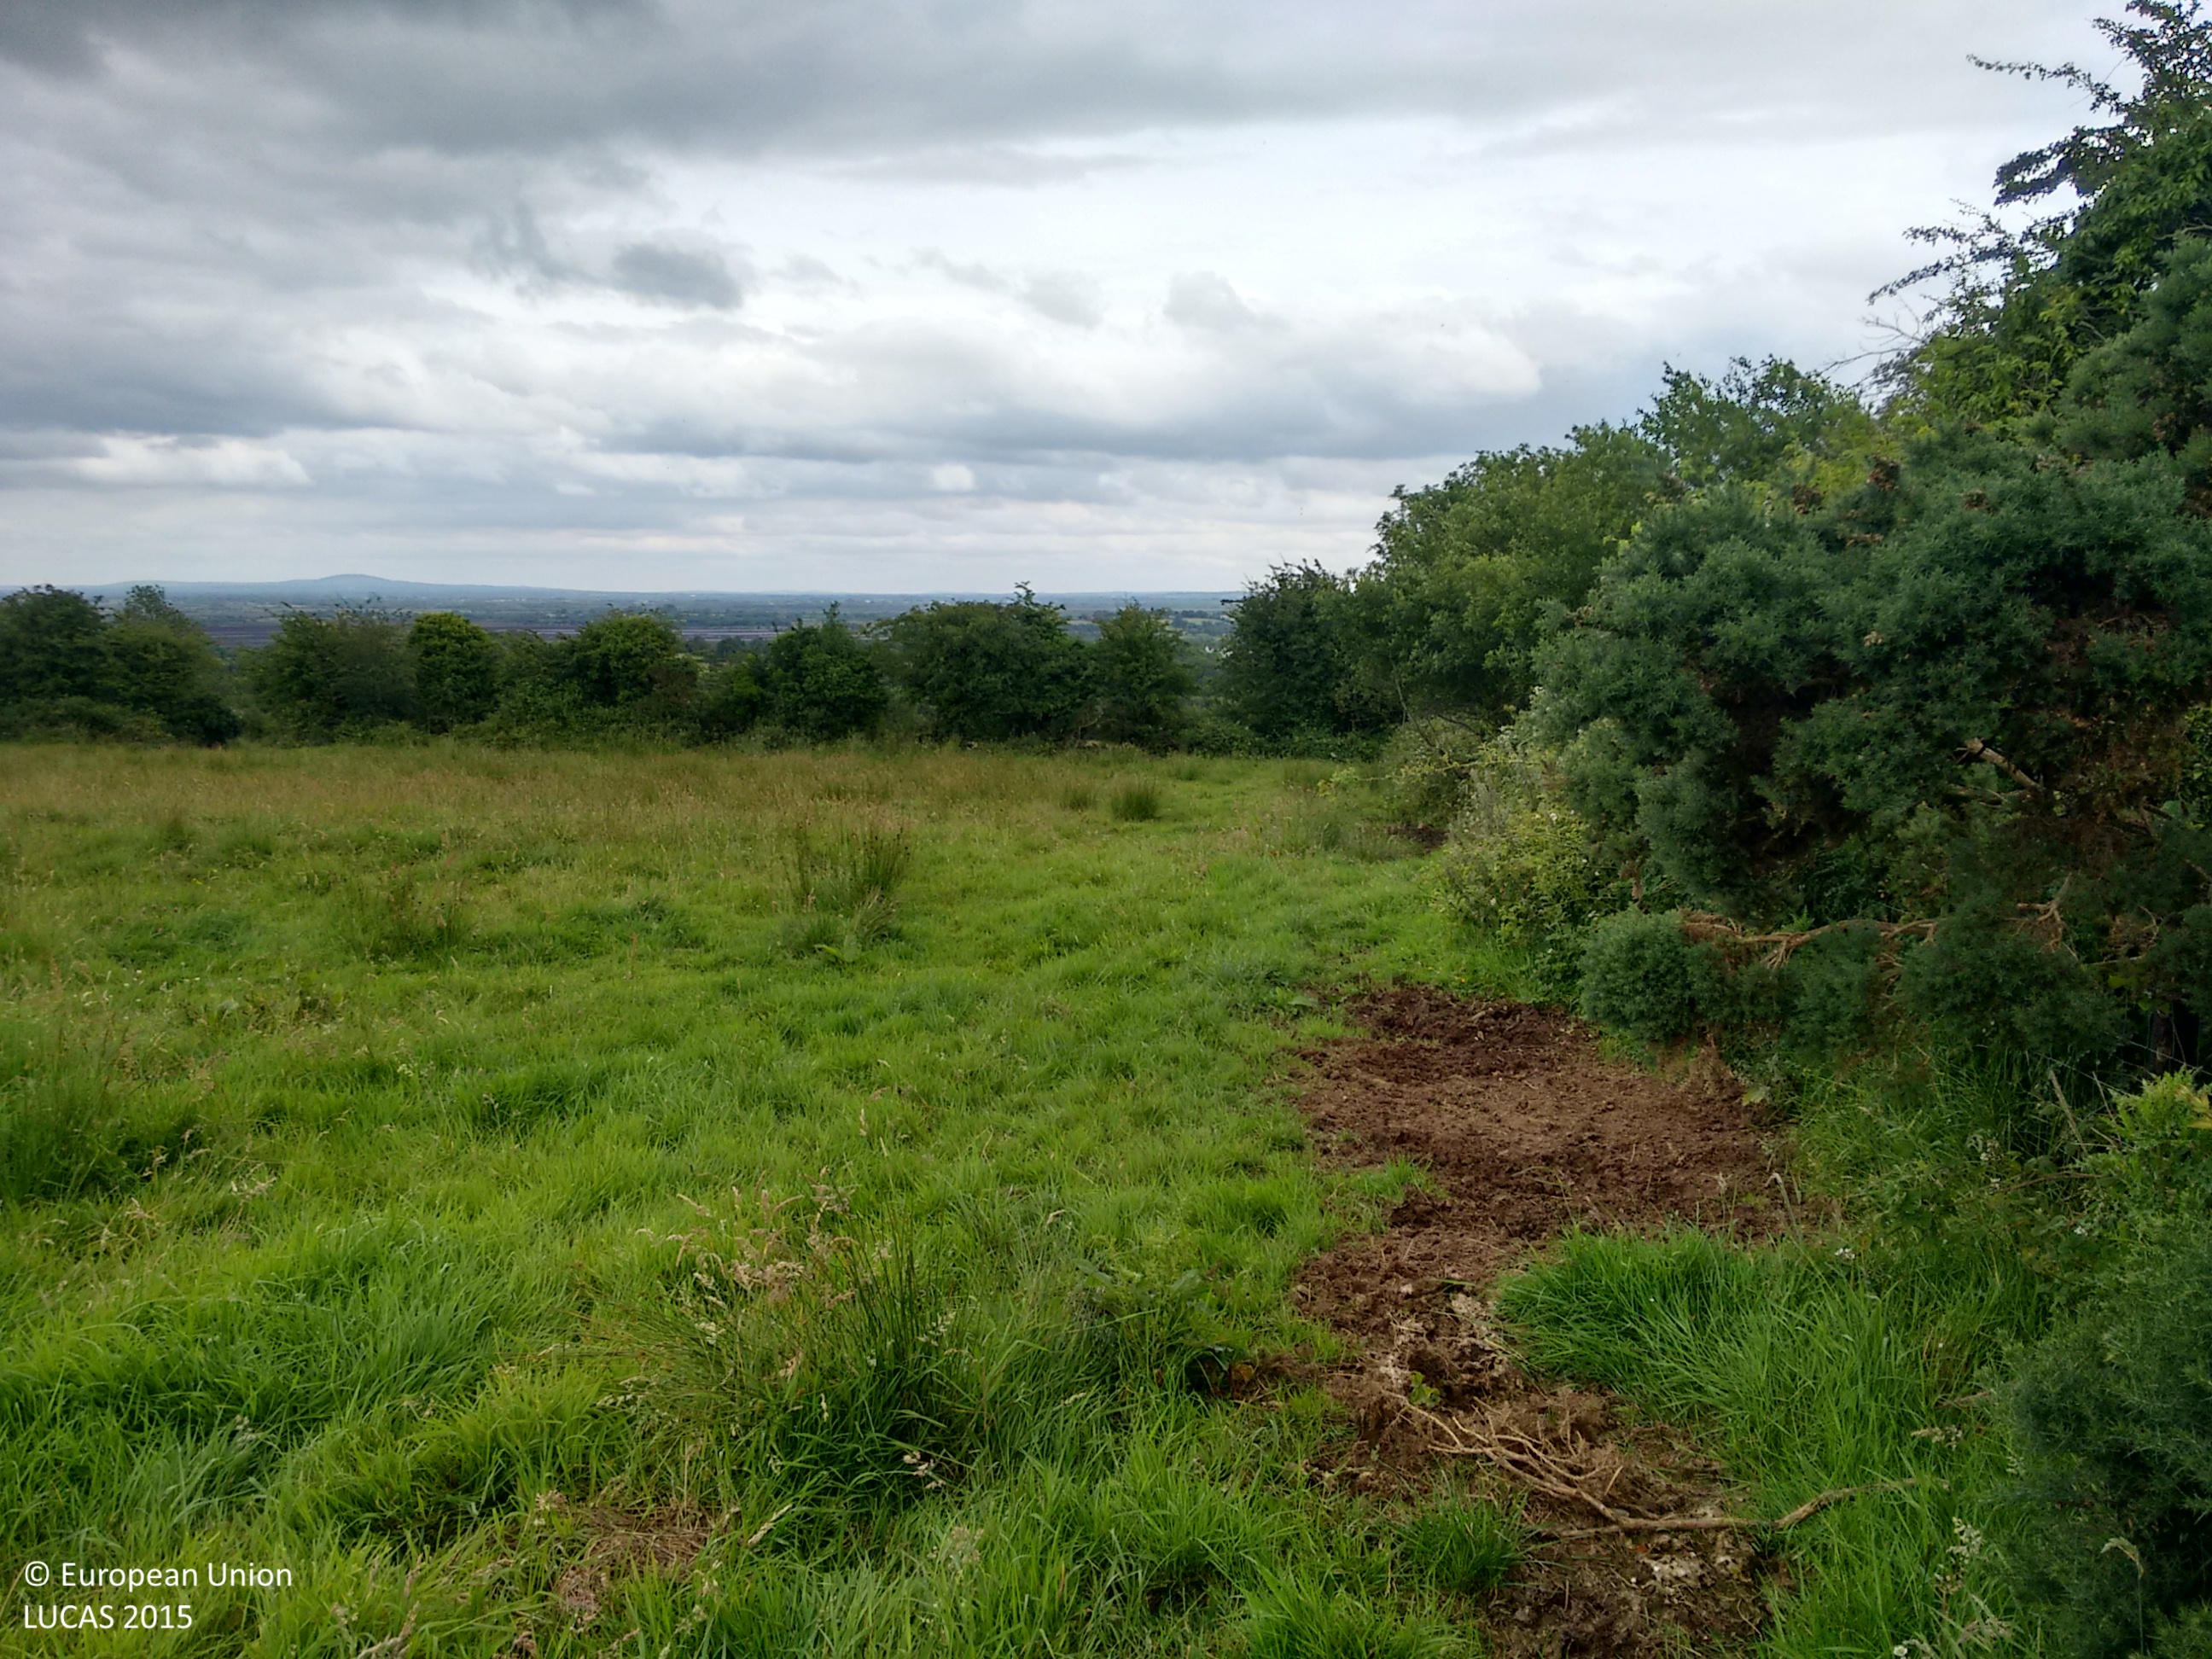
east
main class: Grassland
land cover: Grassland without tree/shrub cover
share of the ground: > 75 %
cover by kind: herbaceous plants 100 %
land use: Agriculture (excluding fallow land and kitchen gardens)
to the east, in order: Grassland without tree/shrub cover; Ditches and canals; Managed hedges; Grassland without tree/shrub cover; Managed hedges; Grassland without tree/shrub cover; Ditches and canals; Grassland without tree/shrub cover; Managed hedges; Grassland without tree/shrub cover
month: July
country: IE
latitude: 53.7274
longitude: -8.0462
